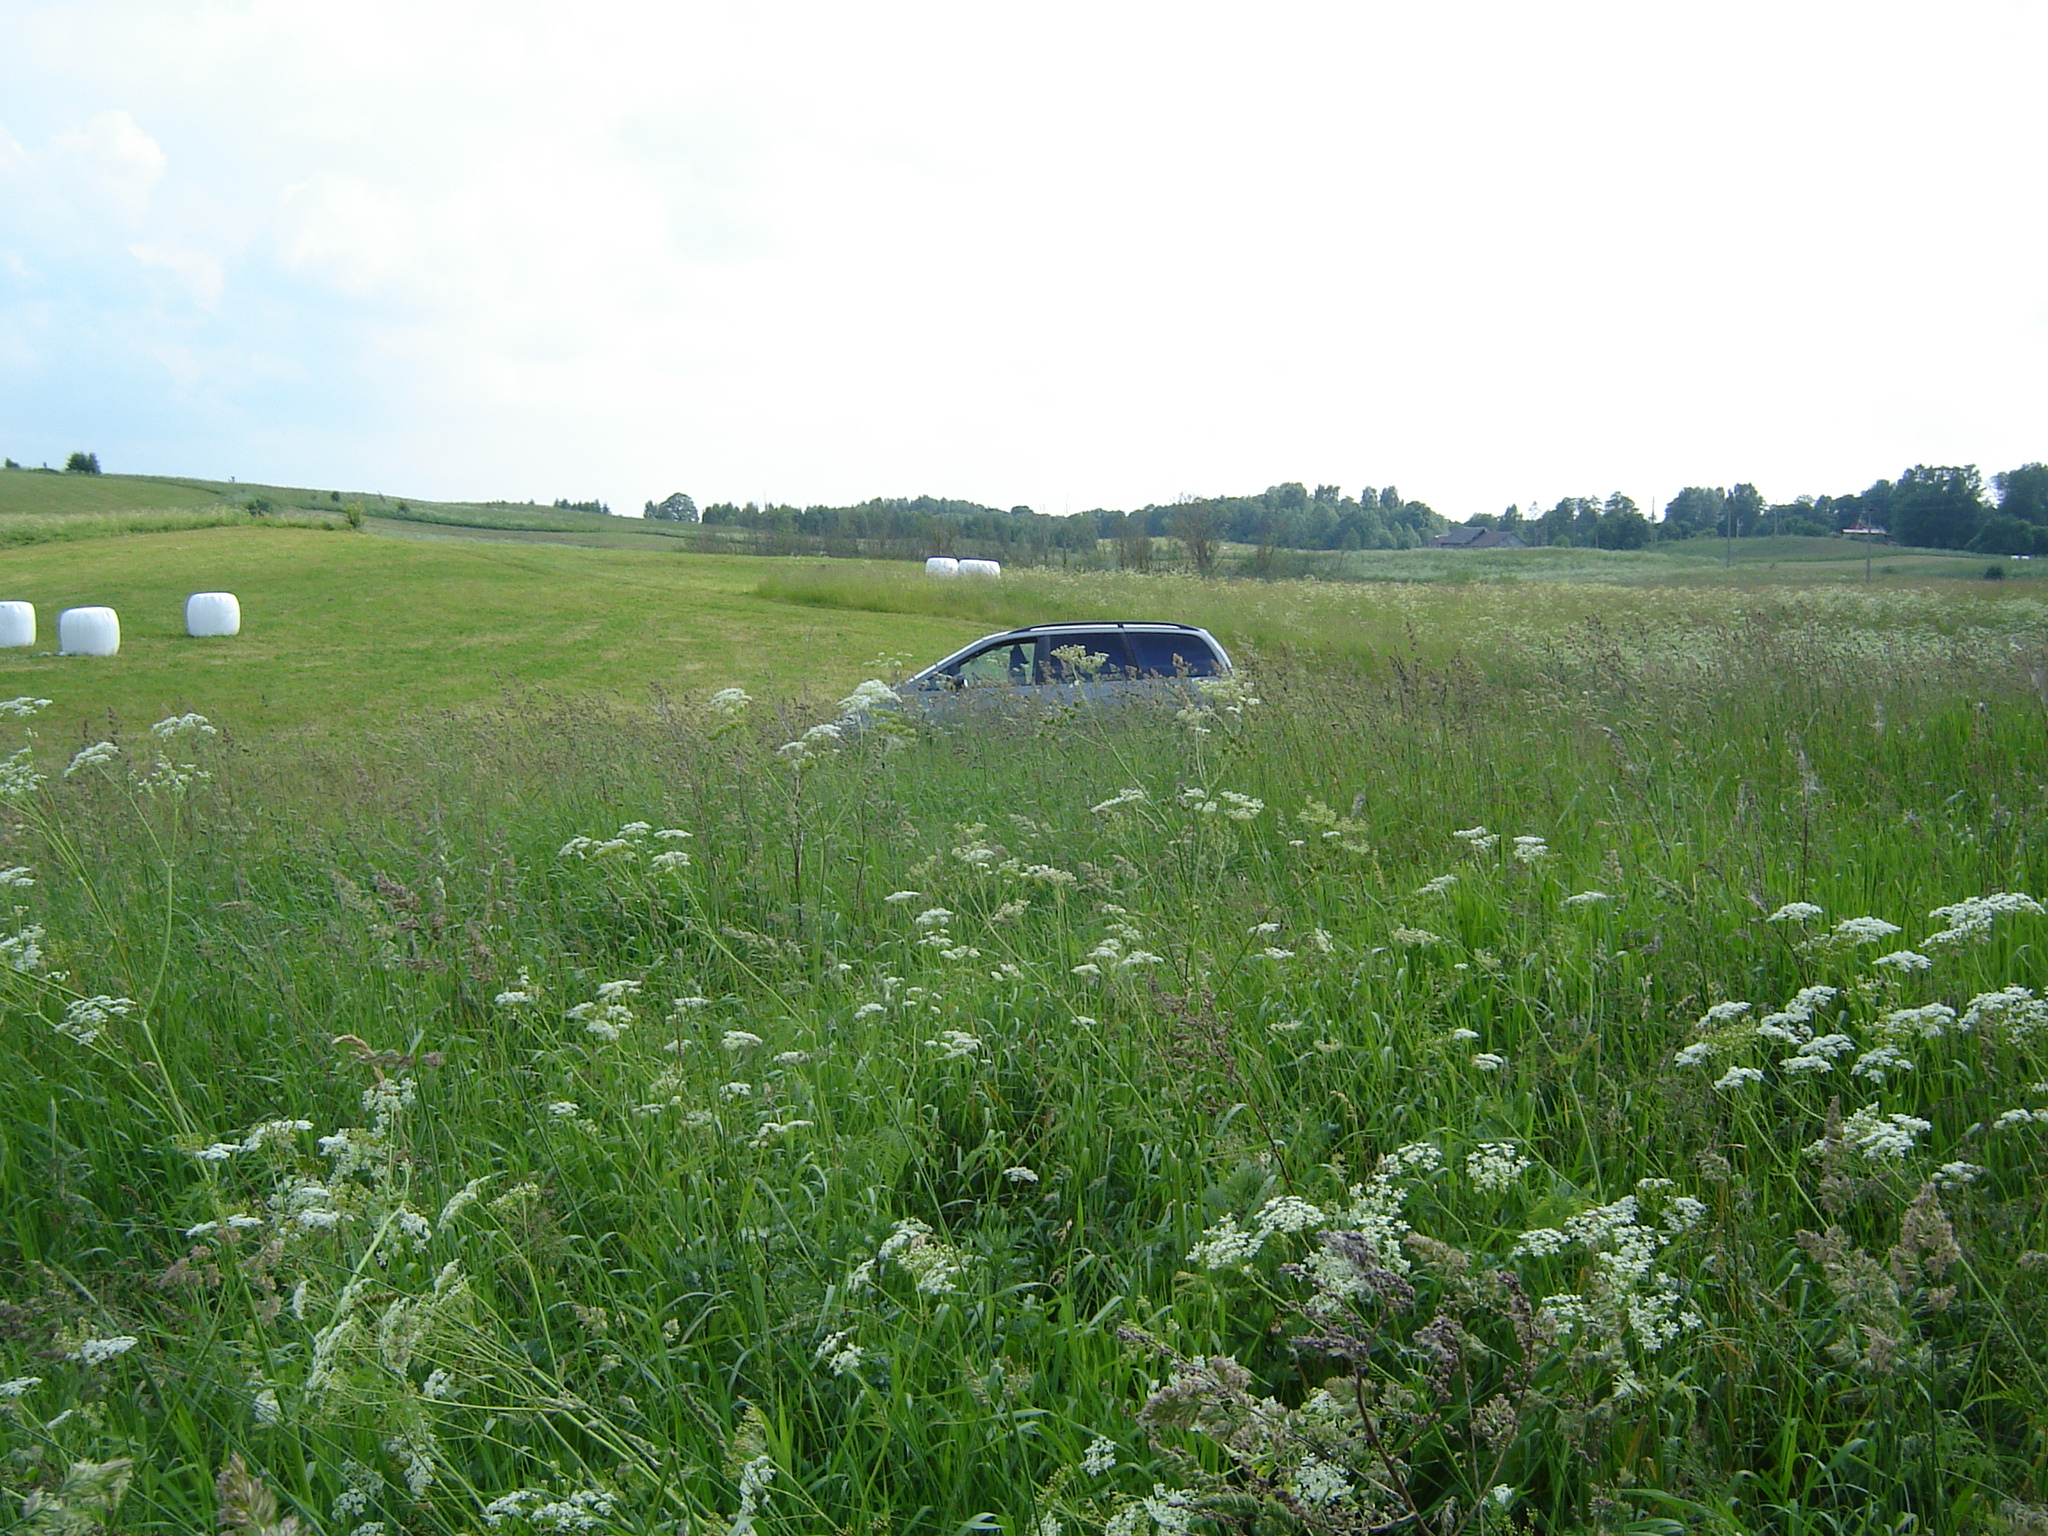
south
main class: Grassland
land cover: Grassland without tree/shrub cover
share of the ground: > 75 %
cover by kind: herbaceous plants 100 %
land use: Agriculture (excluding fallow land and kitchen gardens)
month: June
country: LT
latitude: 55.4776
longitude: 25.4870
